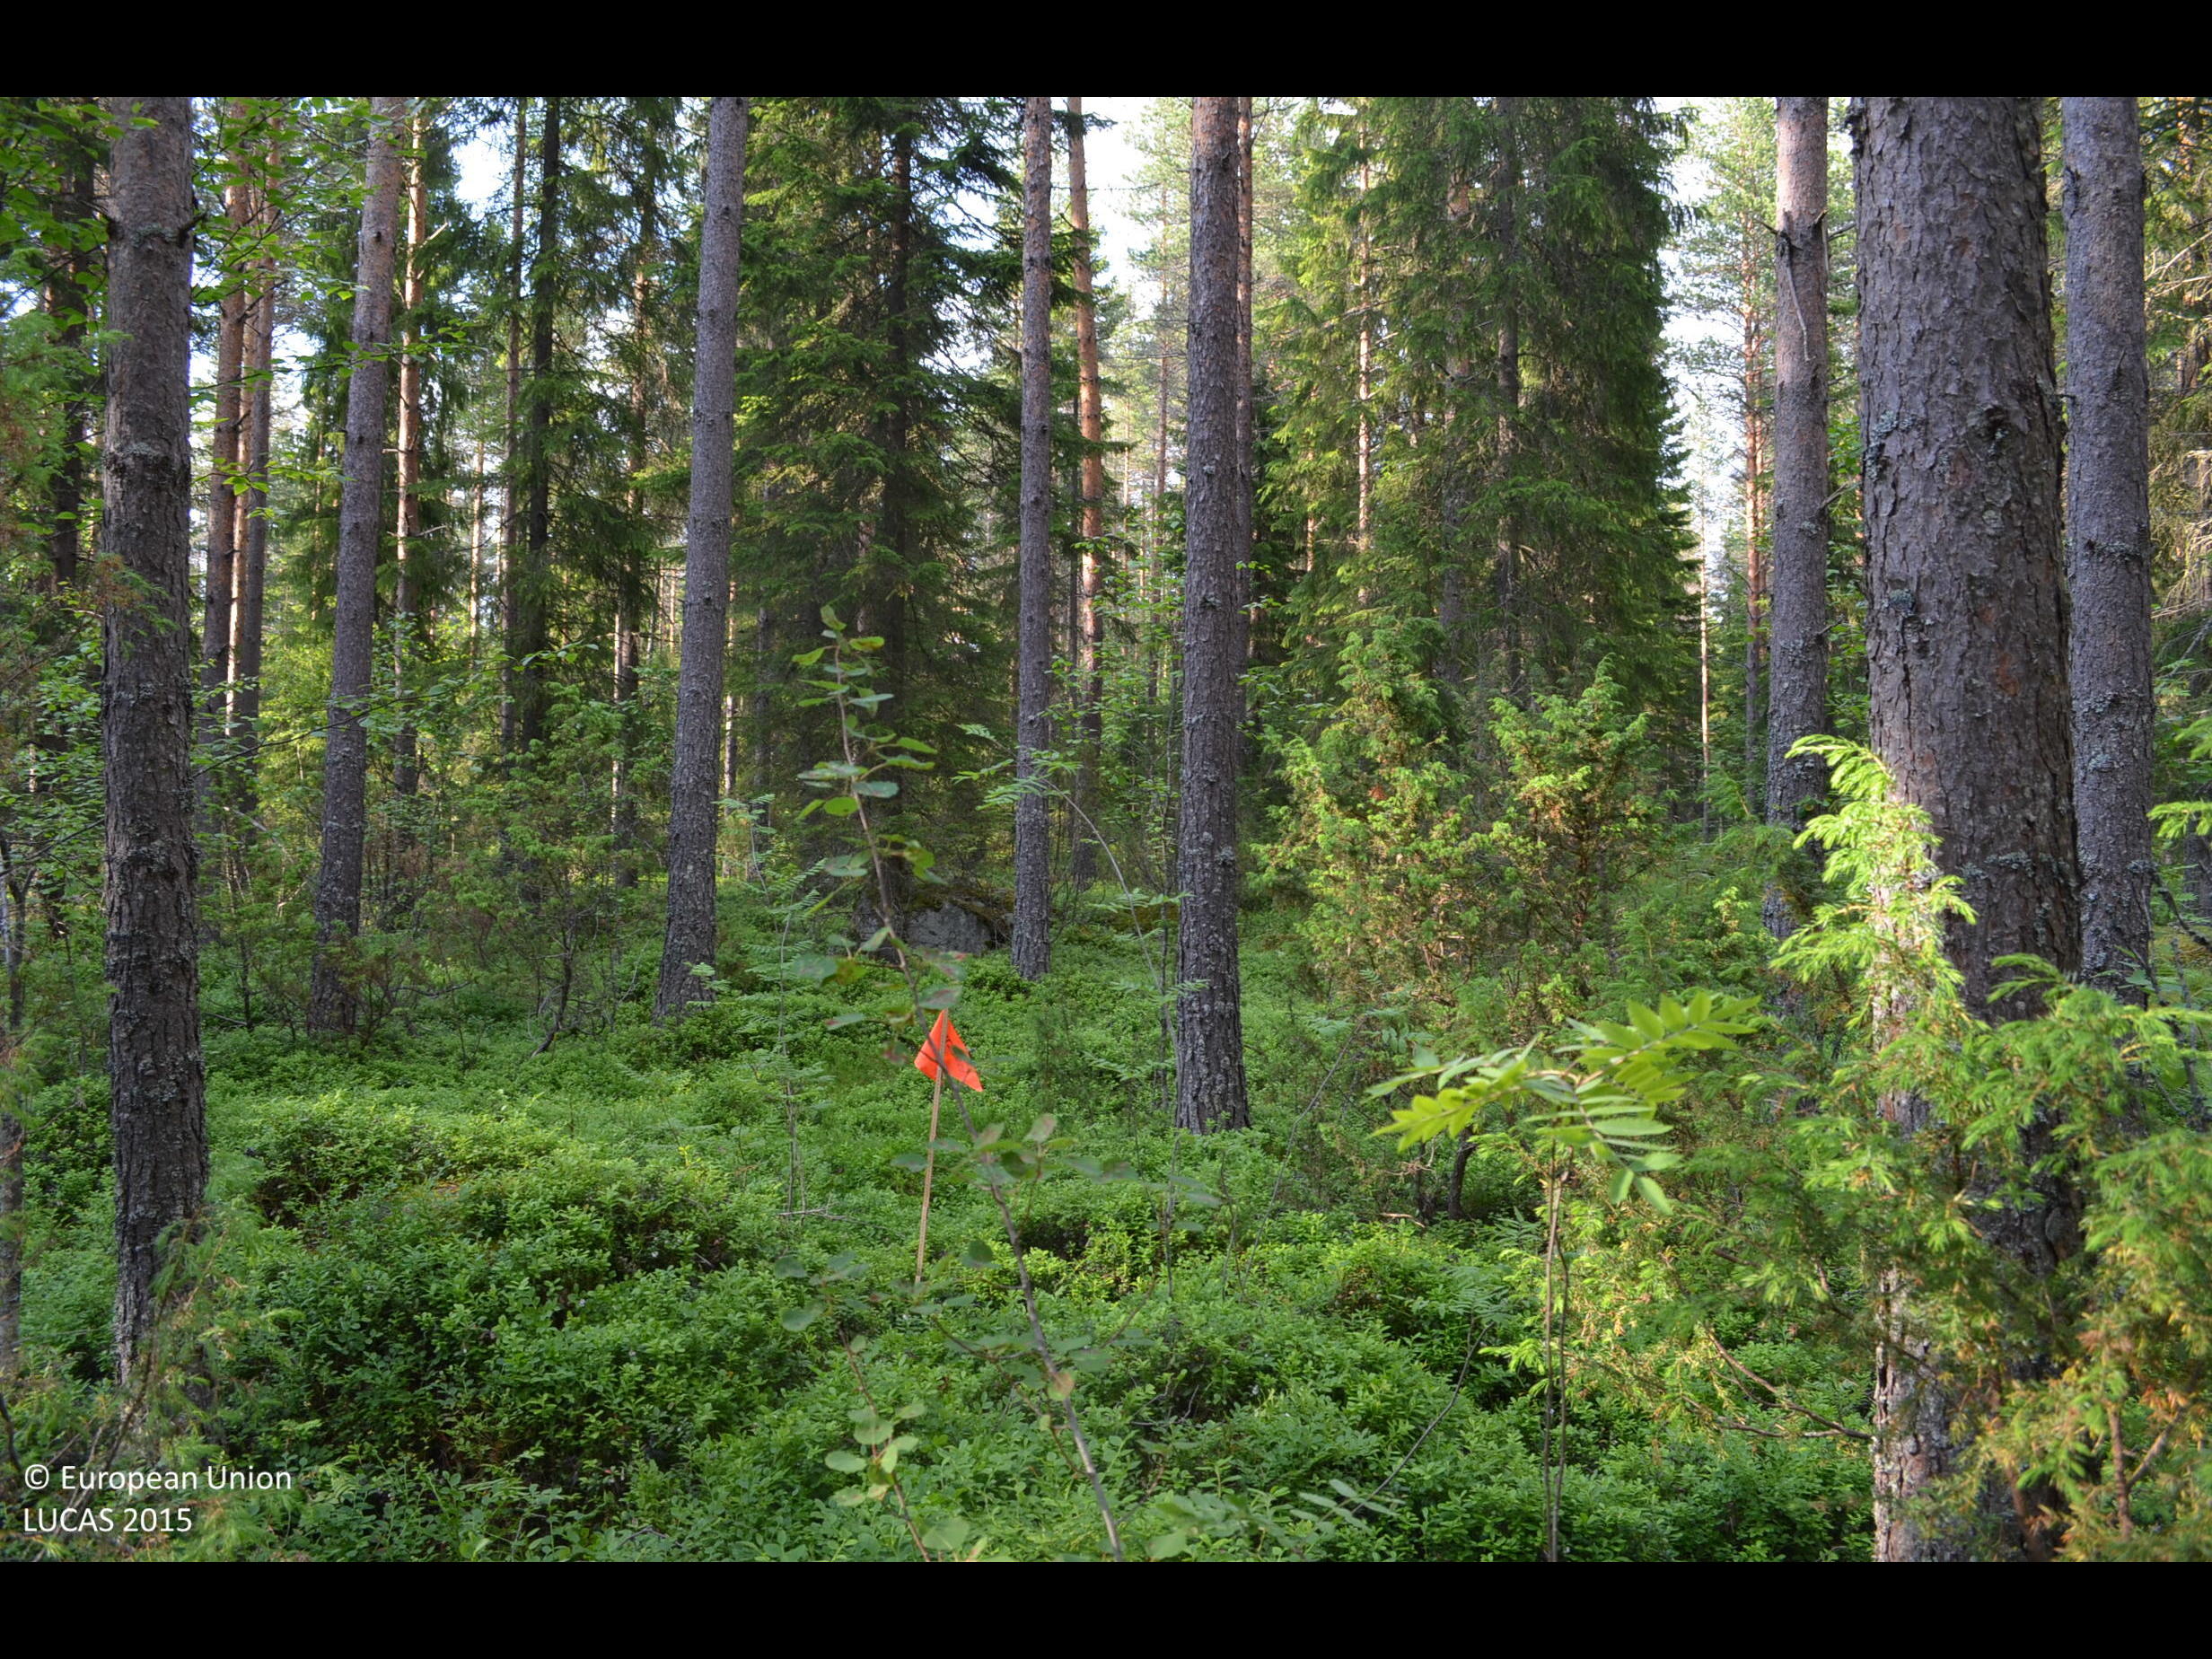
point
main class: Woodland
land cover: Pine dominated coniferous woodland
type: boreal forest
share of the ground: > 75 %
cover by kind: coniferous forest trees 70 %, shrubs 25 %, broadleaved forest trees 5 %
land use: Forestry
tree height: > 5 m
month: July
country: FI
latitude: 62.2825
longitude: 23.4275
